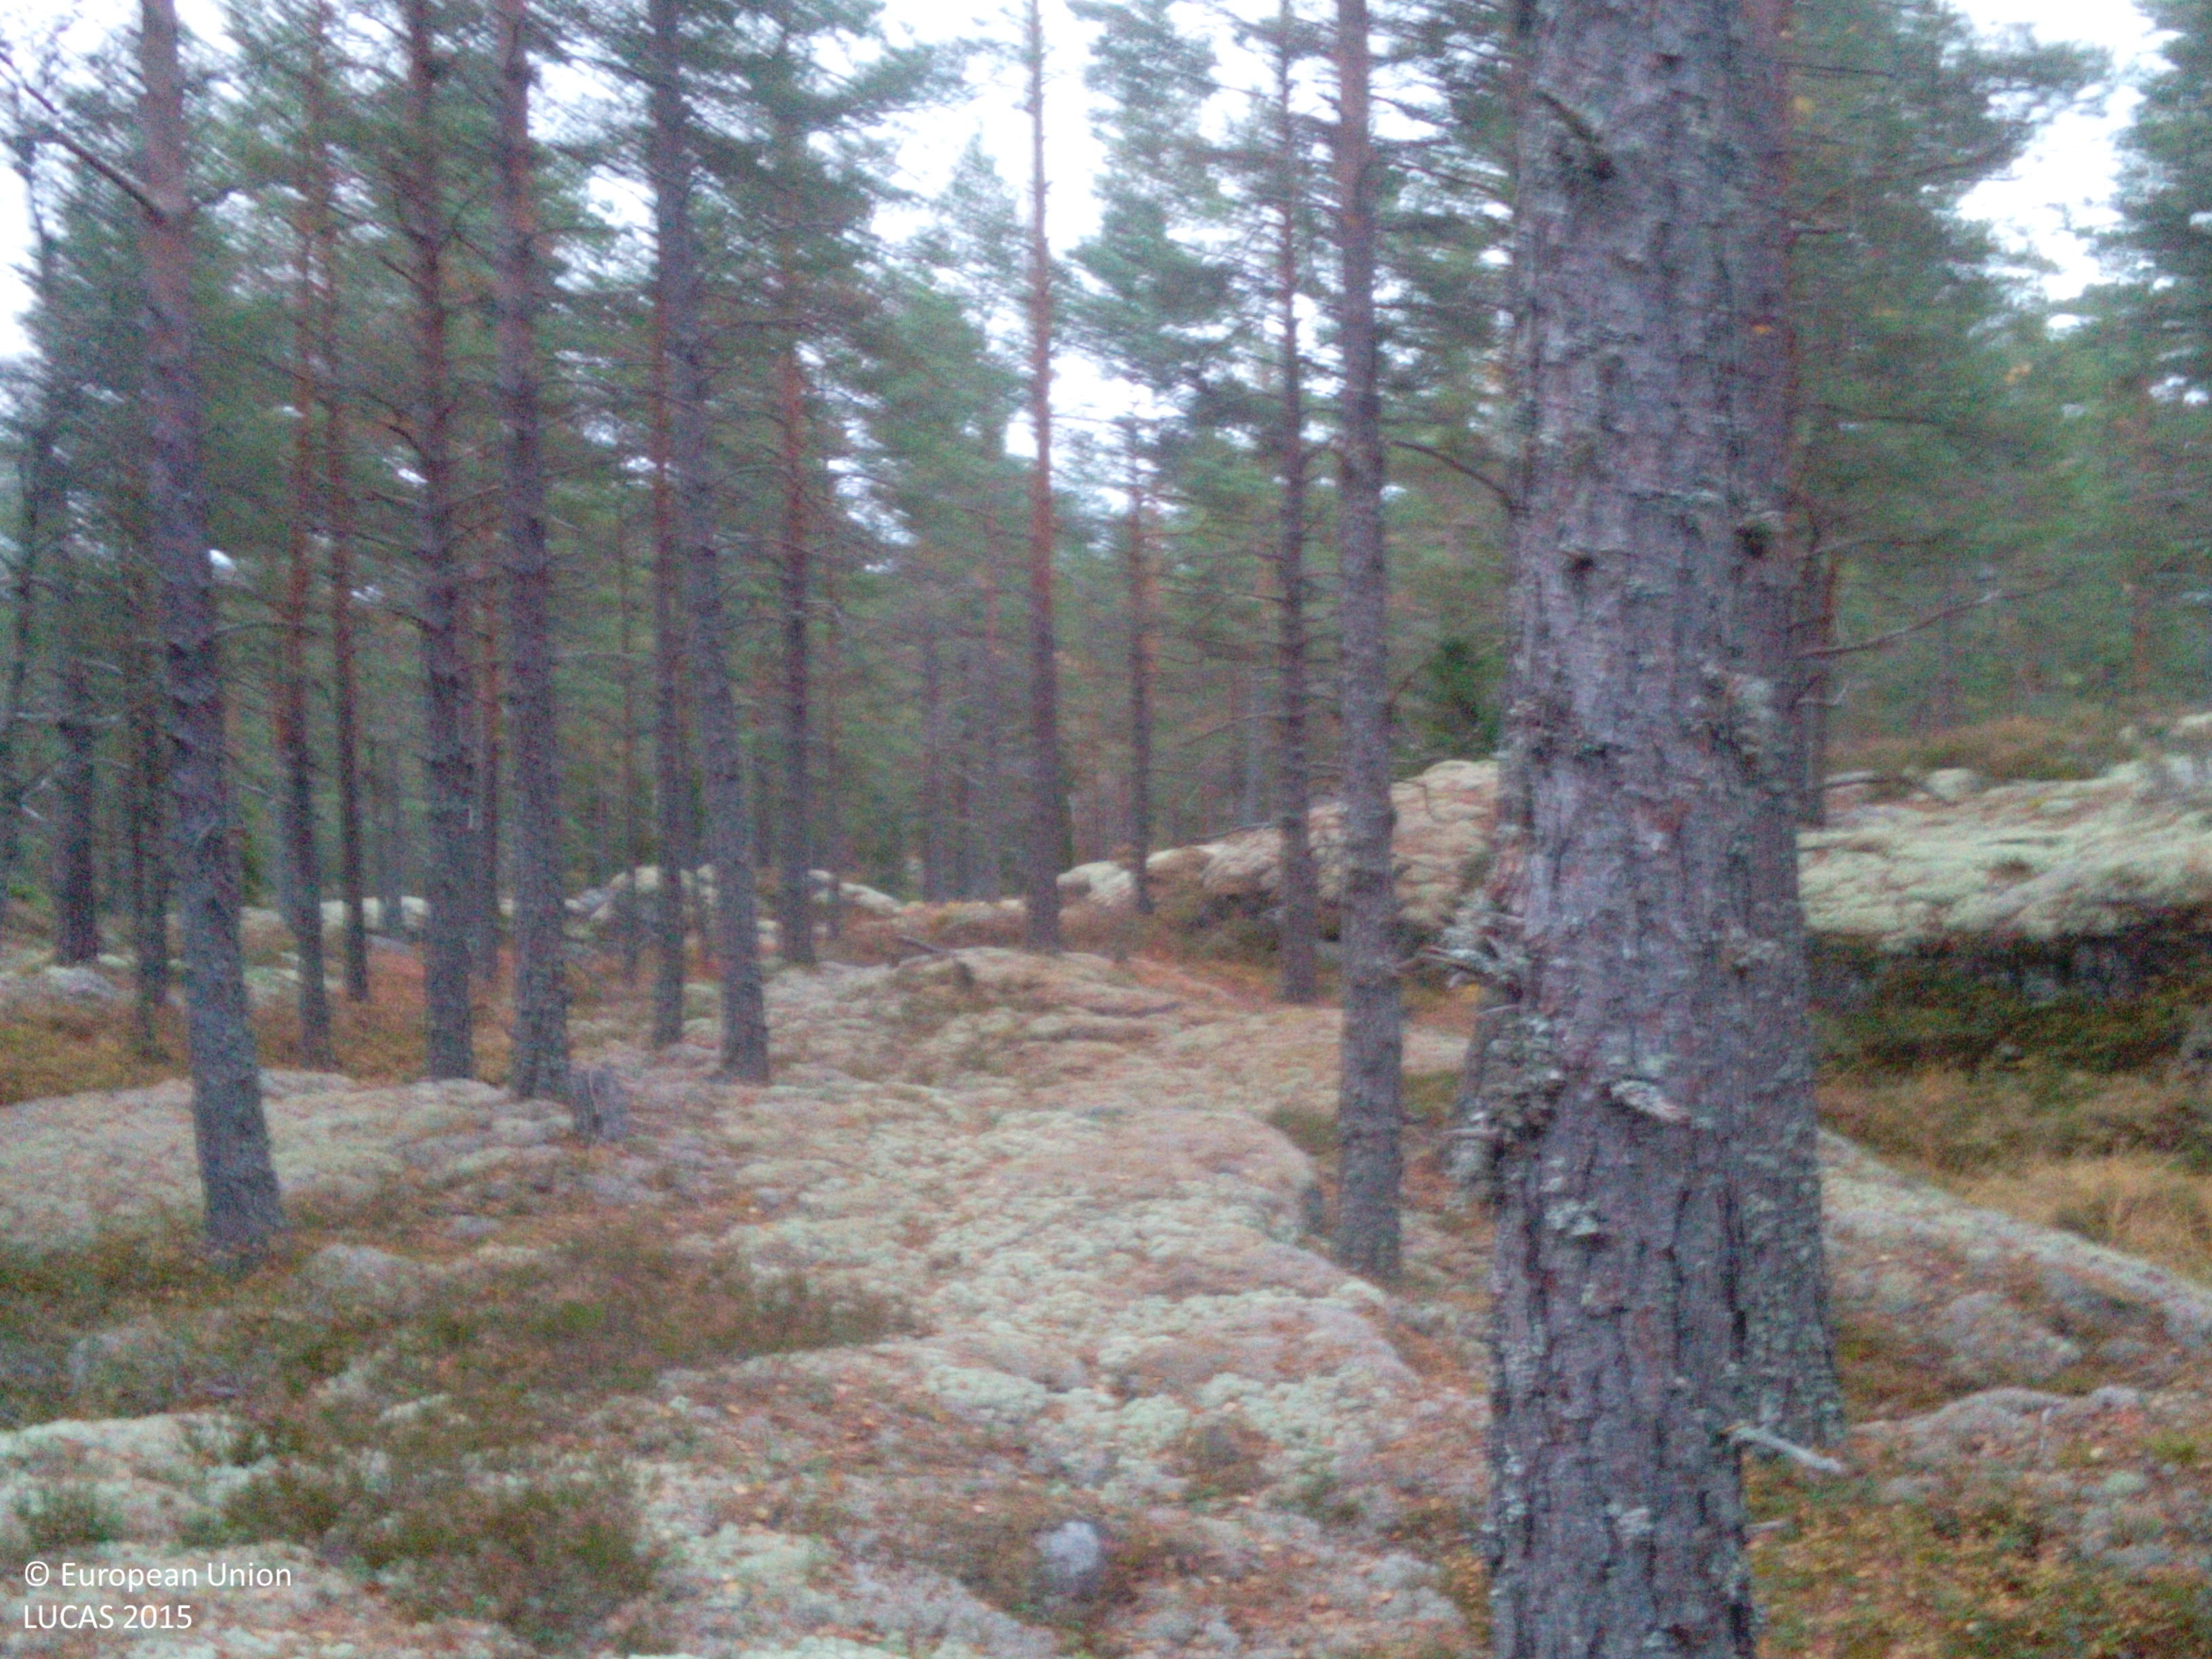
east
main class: Woodland
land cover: Pine dominated coniferous woodland
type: boreal forest
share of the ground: 50 - 75 %
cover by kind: coniferous forest trees 50 %, herbaceous plants 25 %, lichens and mosses 25 %
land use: Forestry
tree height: > 5 m
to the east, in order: Pine dominated coniferous woodland; Other coniferous woodland
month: October
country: SE
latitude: 59.1678
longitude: 16.4134
